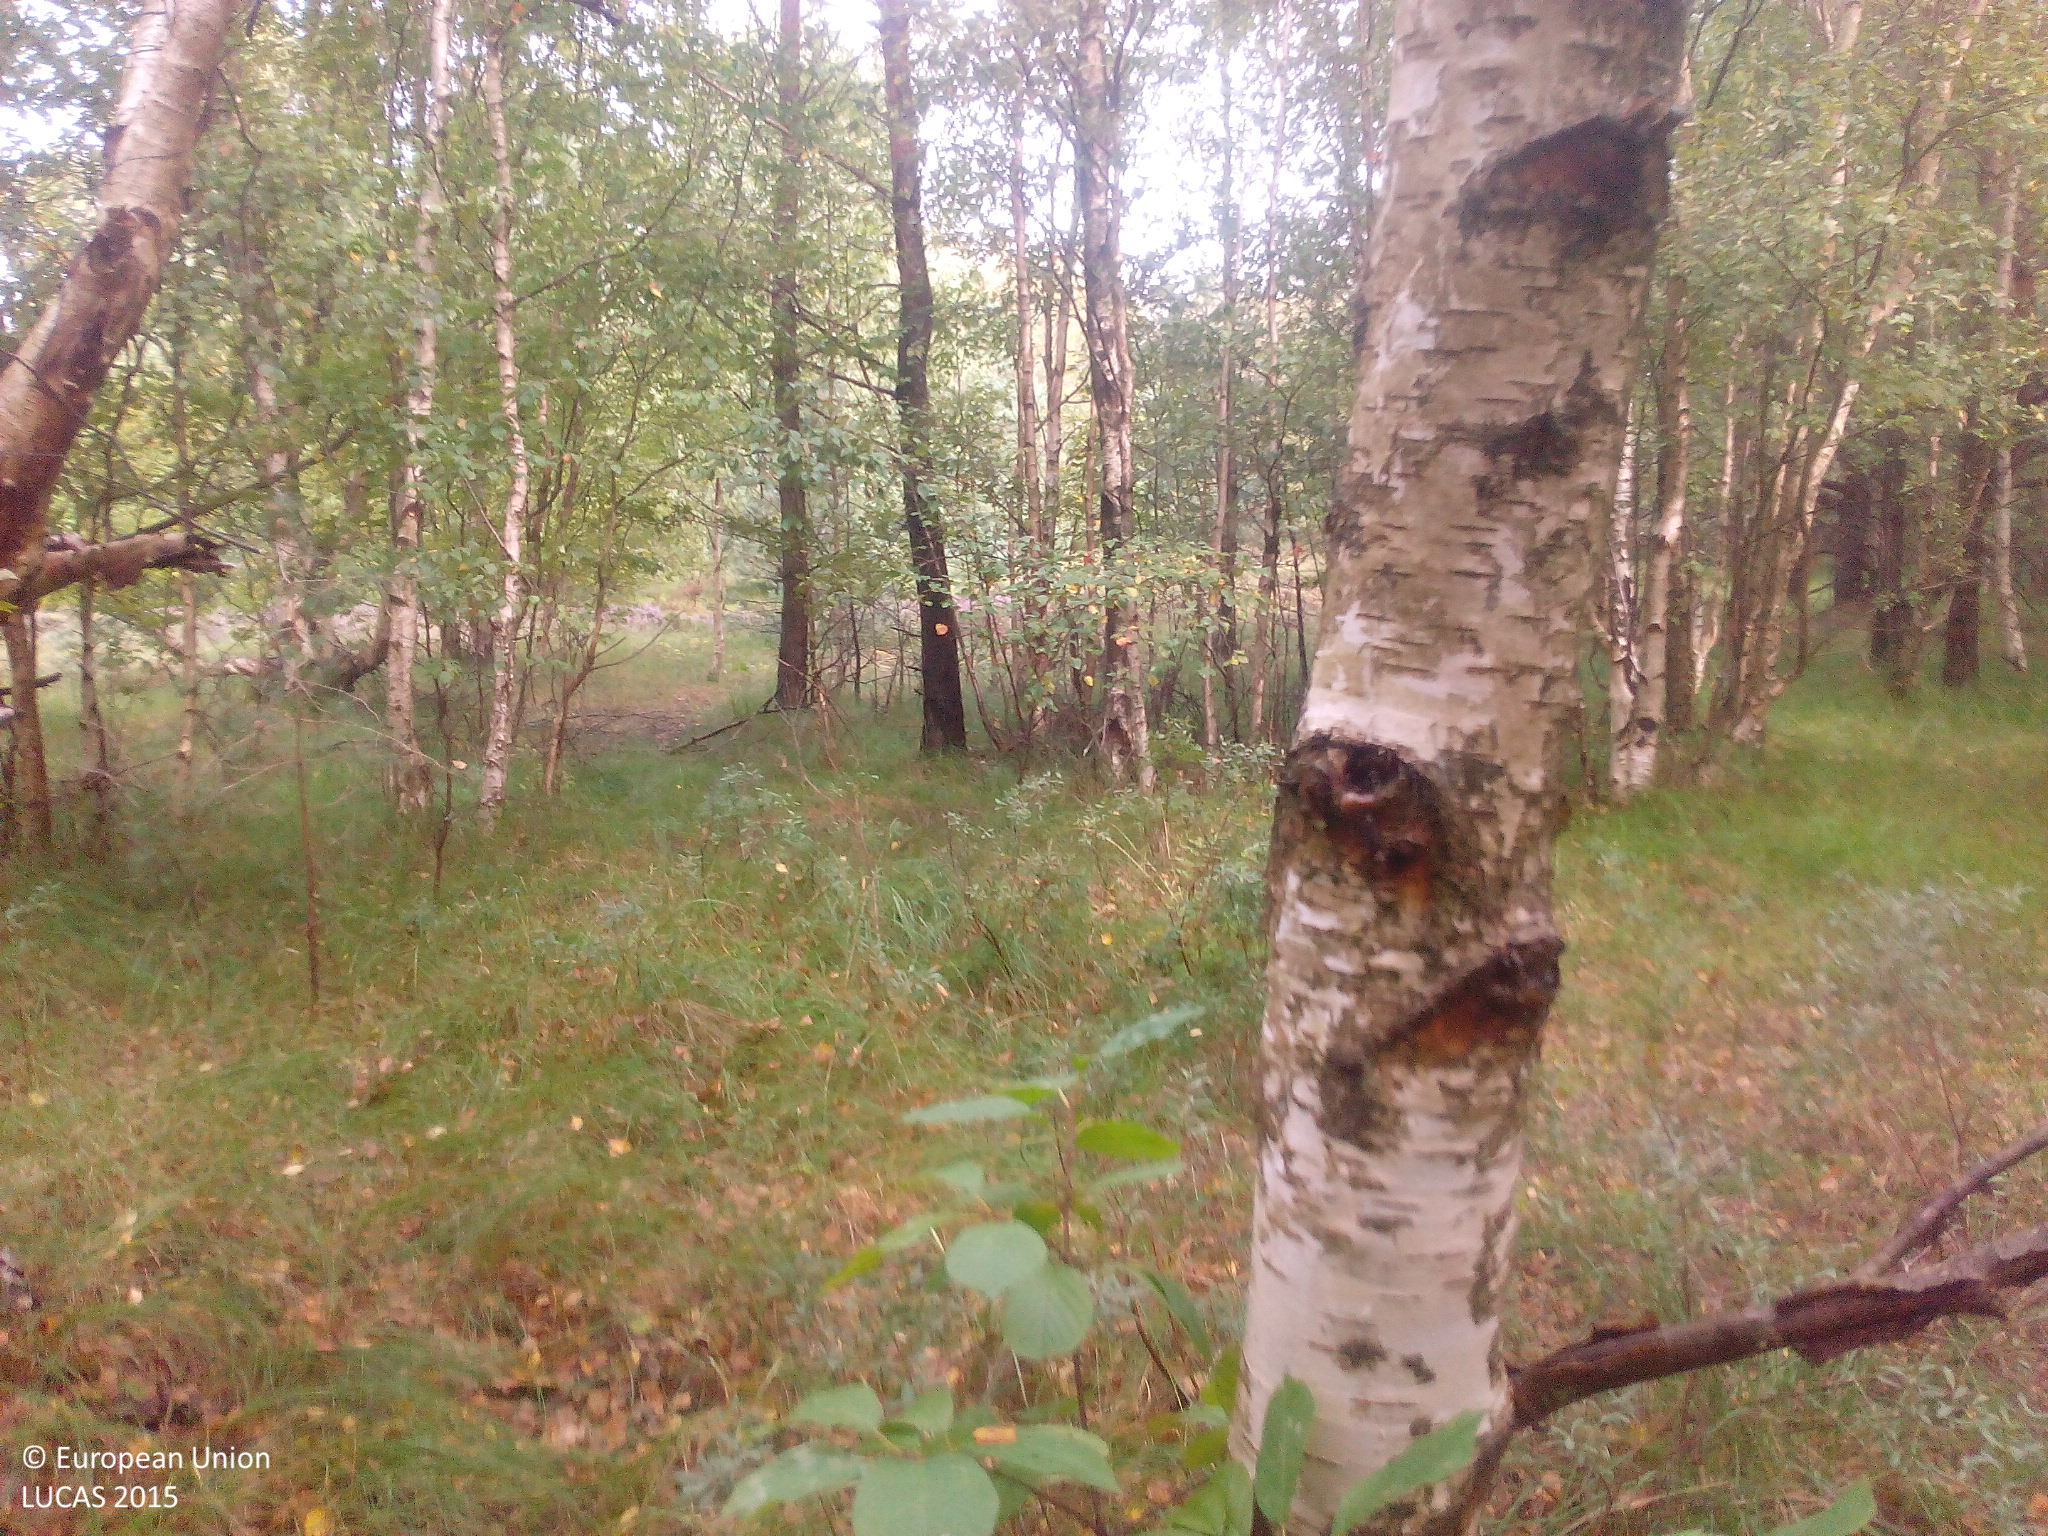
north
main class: Woodland
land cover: Broadleaved woodland
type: mesophytic deciduous forest
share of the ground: > 75 %
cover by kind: broadleaved forest trees 95 %, herbaceous plants 5 %
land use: Semi-natural and natural areas not in use
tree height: > 5 m
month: August
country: DK
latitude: 57.3151
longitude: 11.1769
